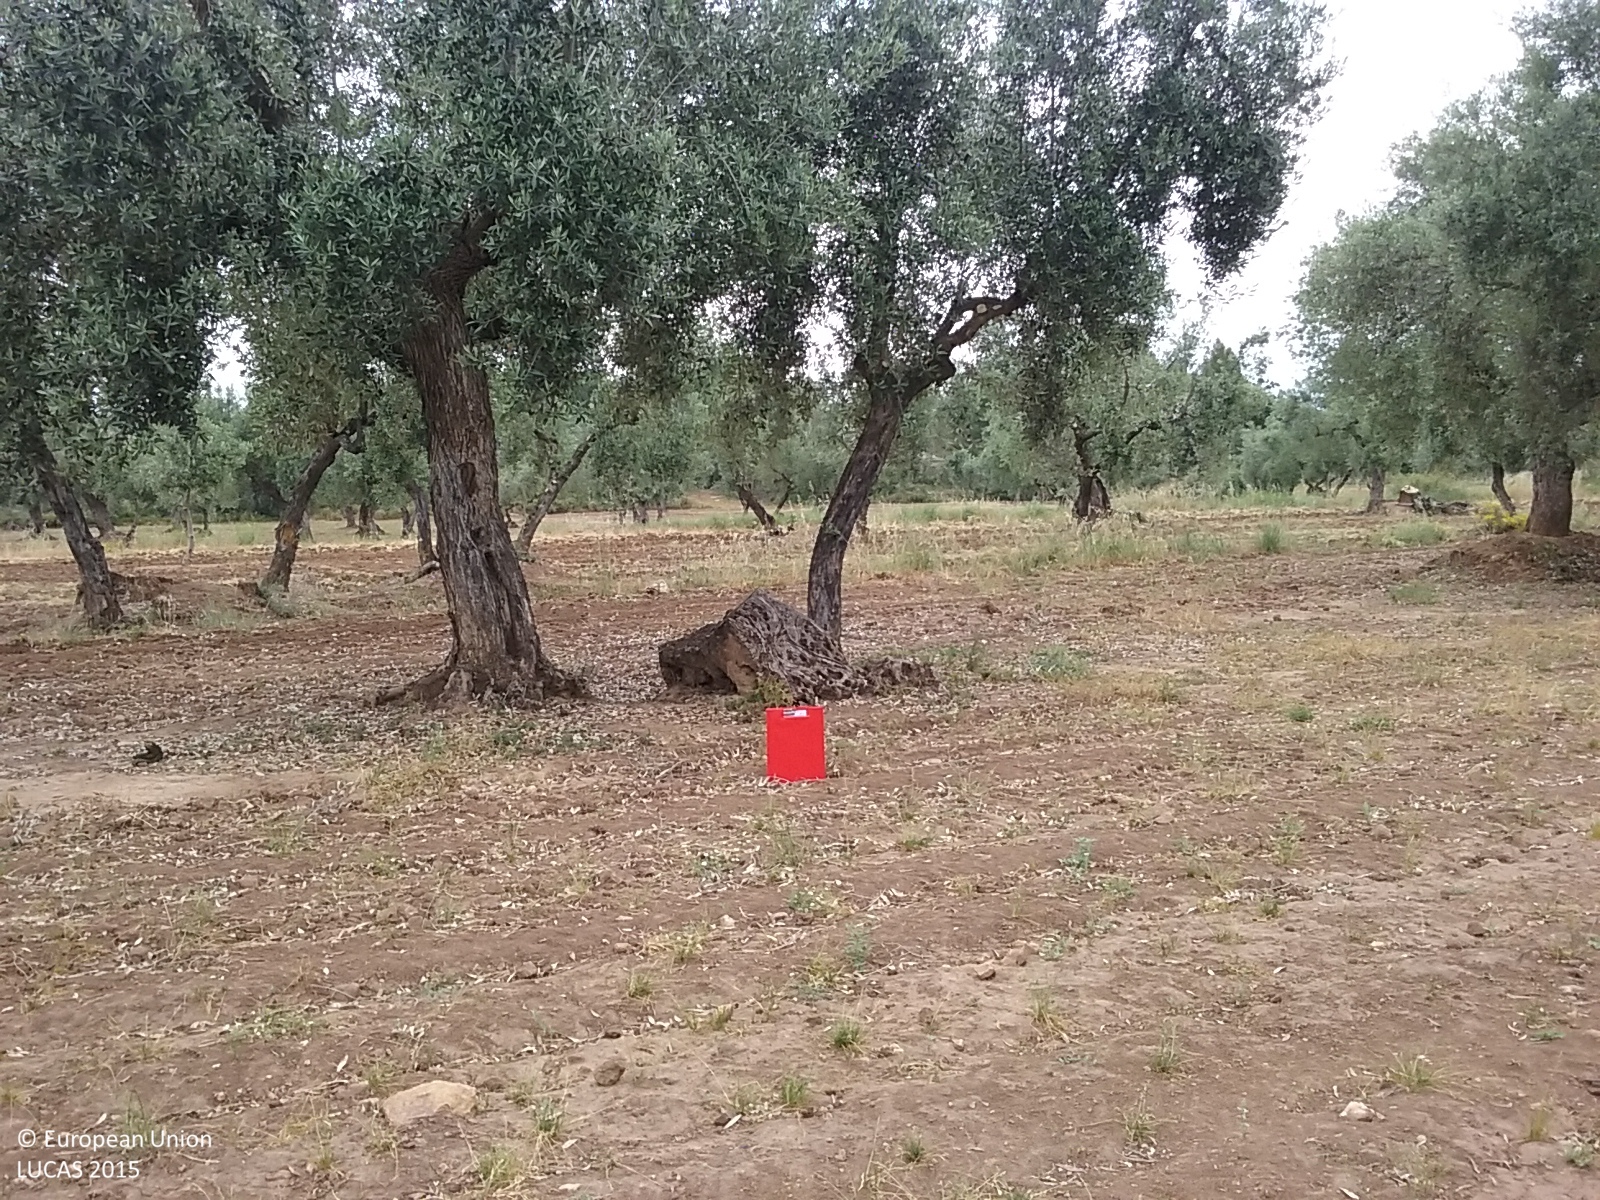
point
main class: Cropland
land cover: Olive groves
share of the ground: 25 - 50 %
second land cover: Spontaneously vegetated surfaces
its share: < 10 %
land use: Agriculture (excluding fallow land and kitchen gardens)
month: June
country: ES
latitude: 40.9221
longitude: 0.1950
